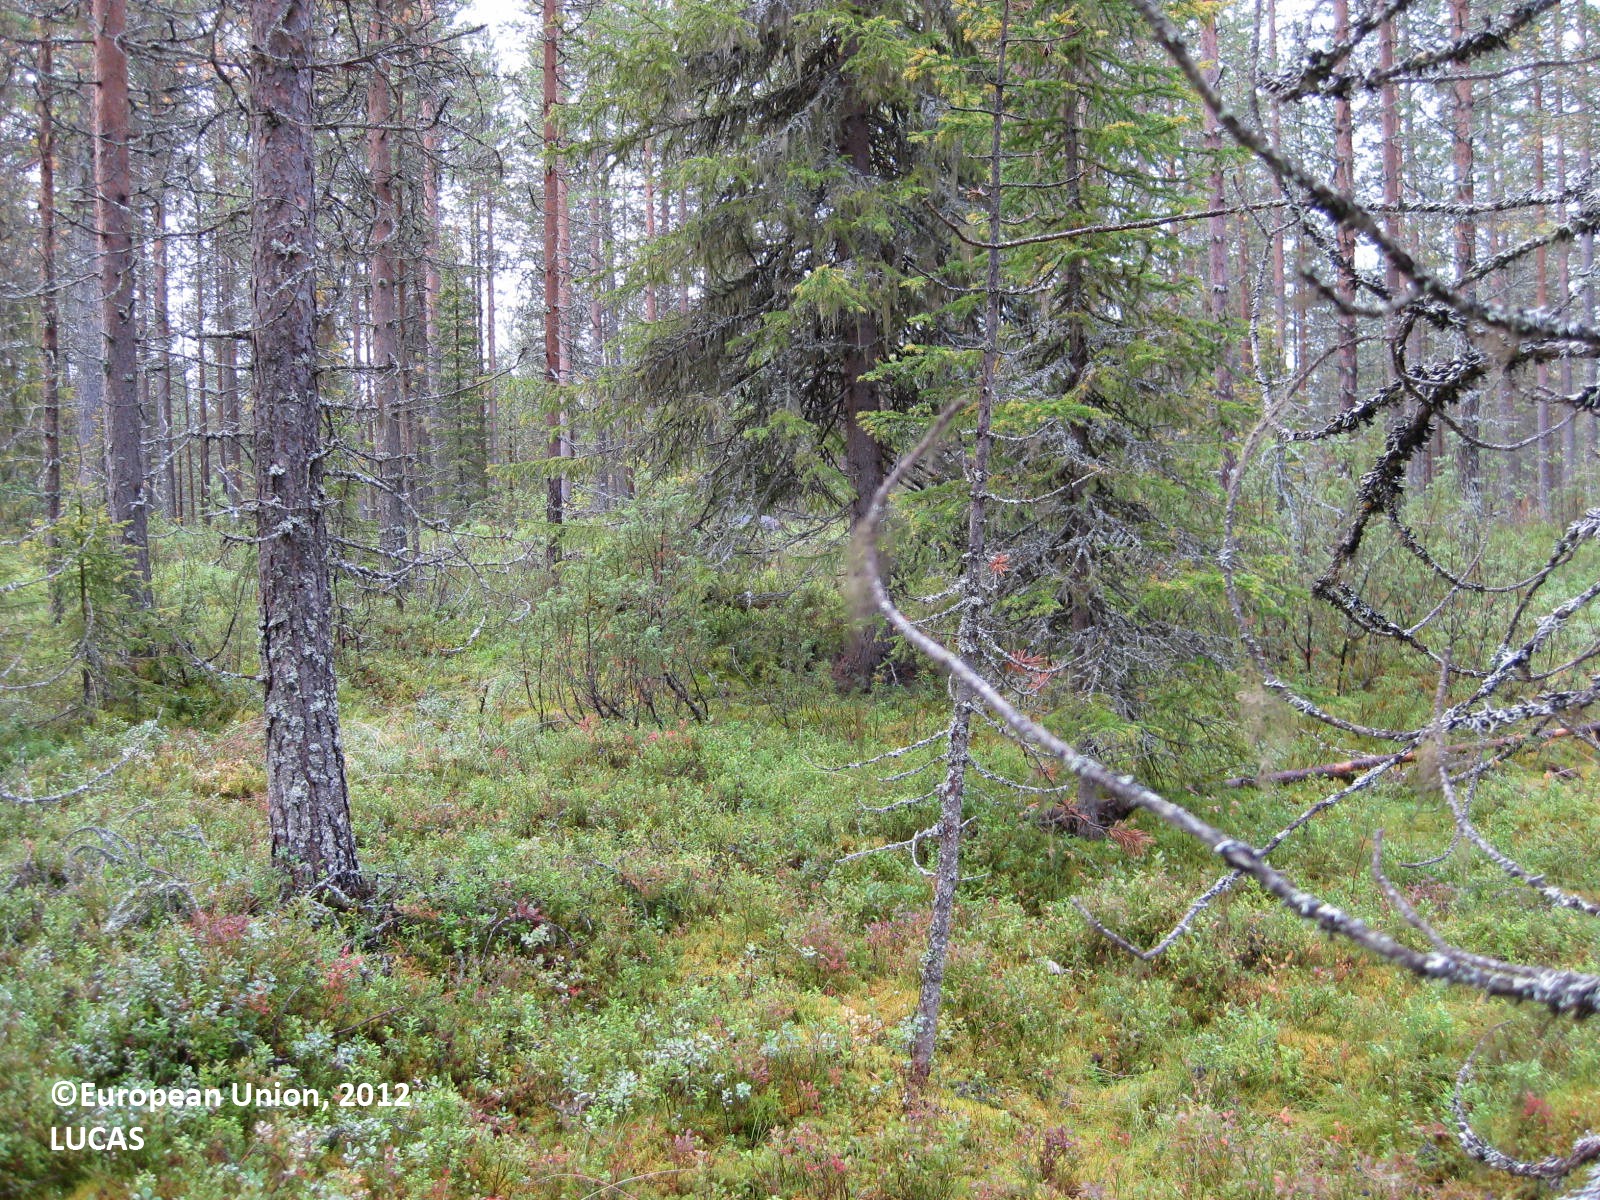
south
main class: Woodland
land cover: Other coniferous woodland
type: boreal forest
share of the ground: 50 - 75 %
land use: Forestry
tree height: > 5 m
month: August
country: FI
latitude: 66.0668
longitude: 28.7855
